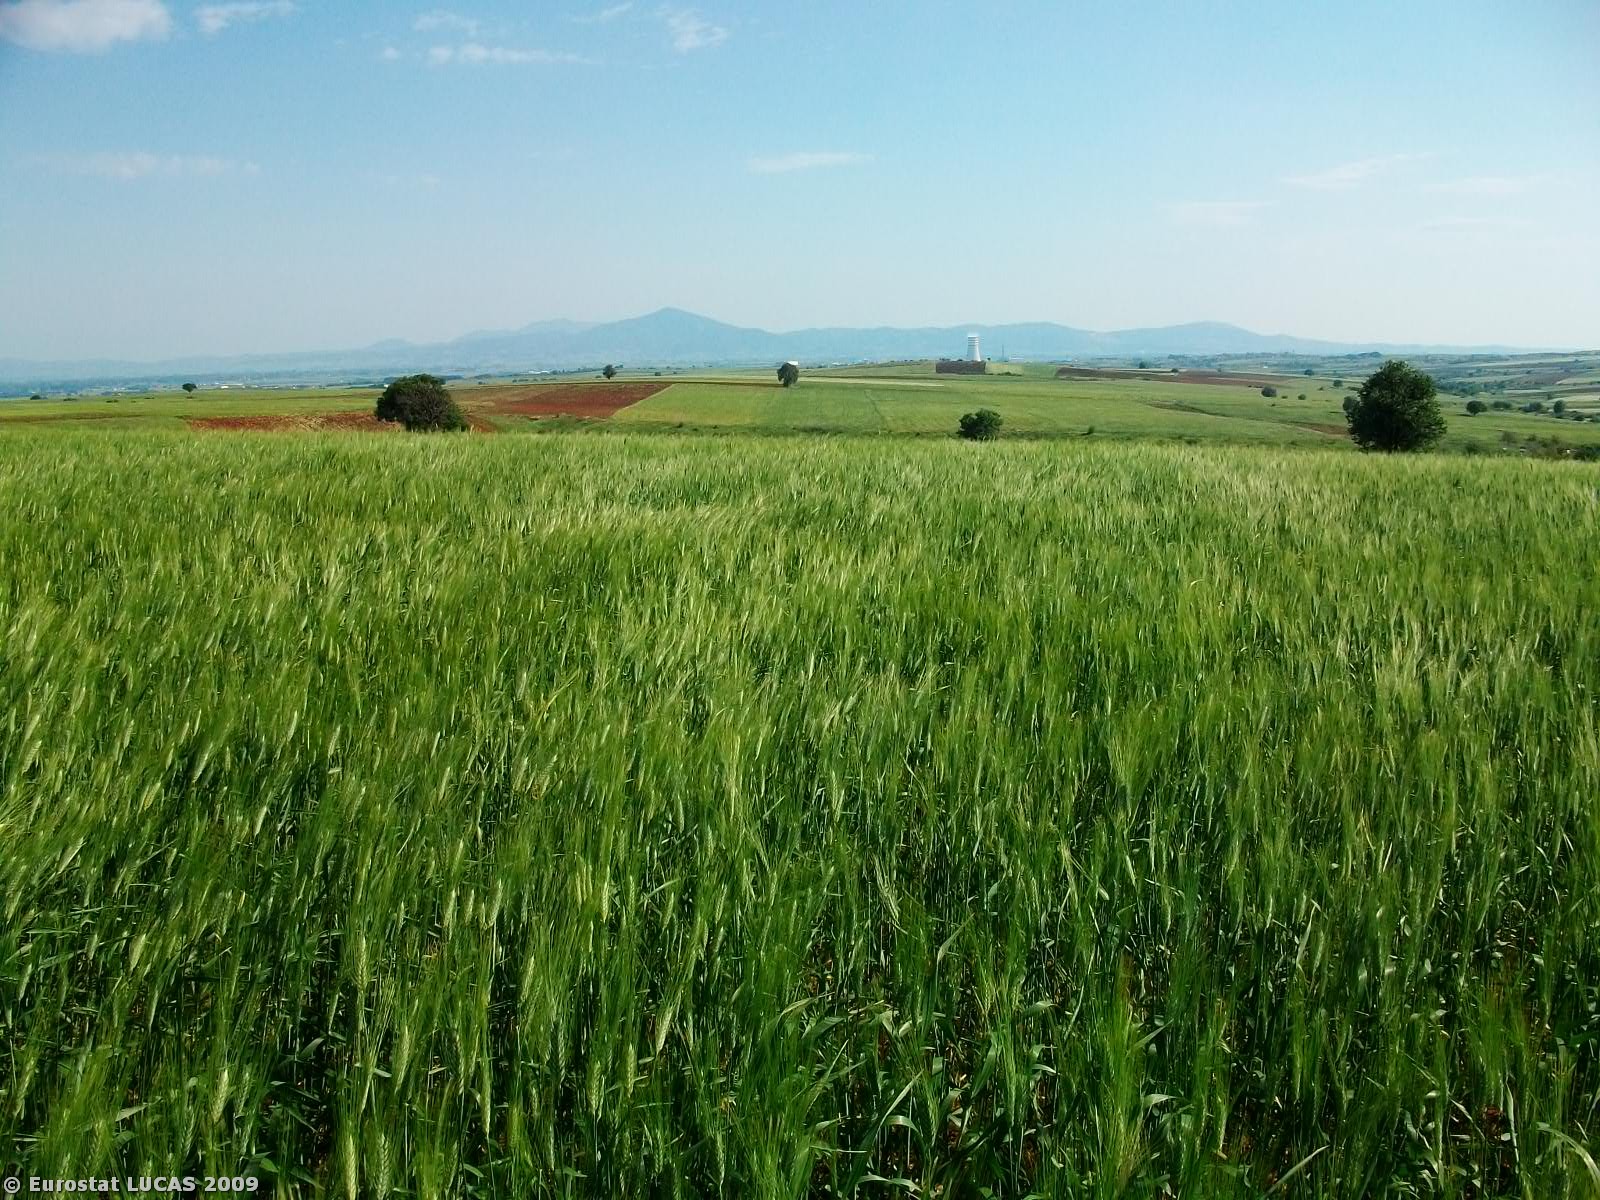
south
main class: Cropland
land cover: Durum wheat
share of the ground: > 75 %
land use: Agriculture (excluding fallow land and kitchen gardens)
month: May
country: GR
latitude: 41.1219
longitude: 25.5003
